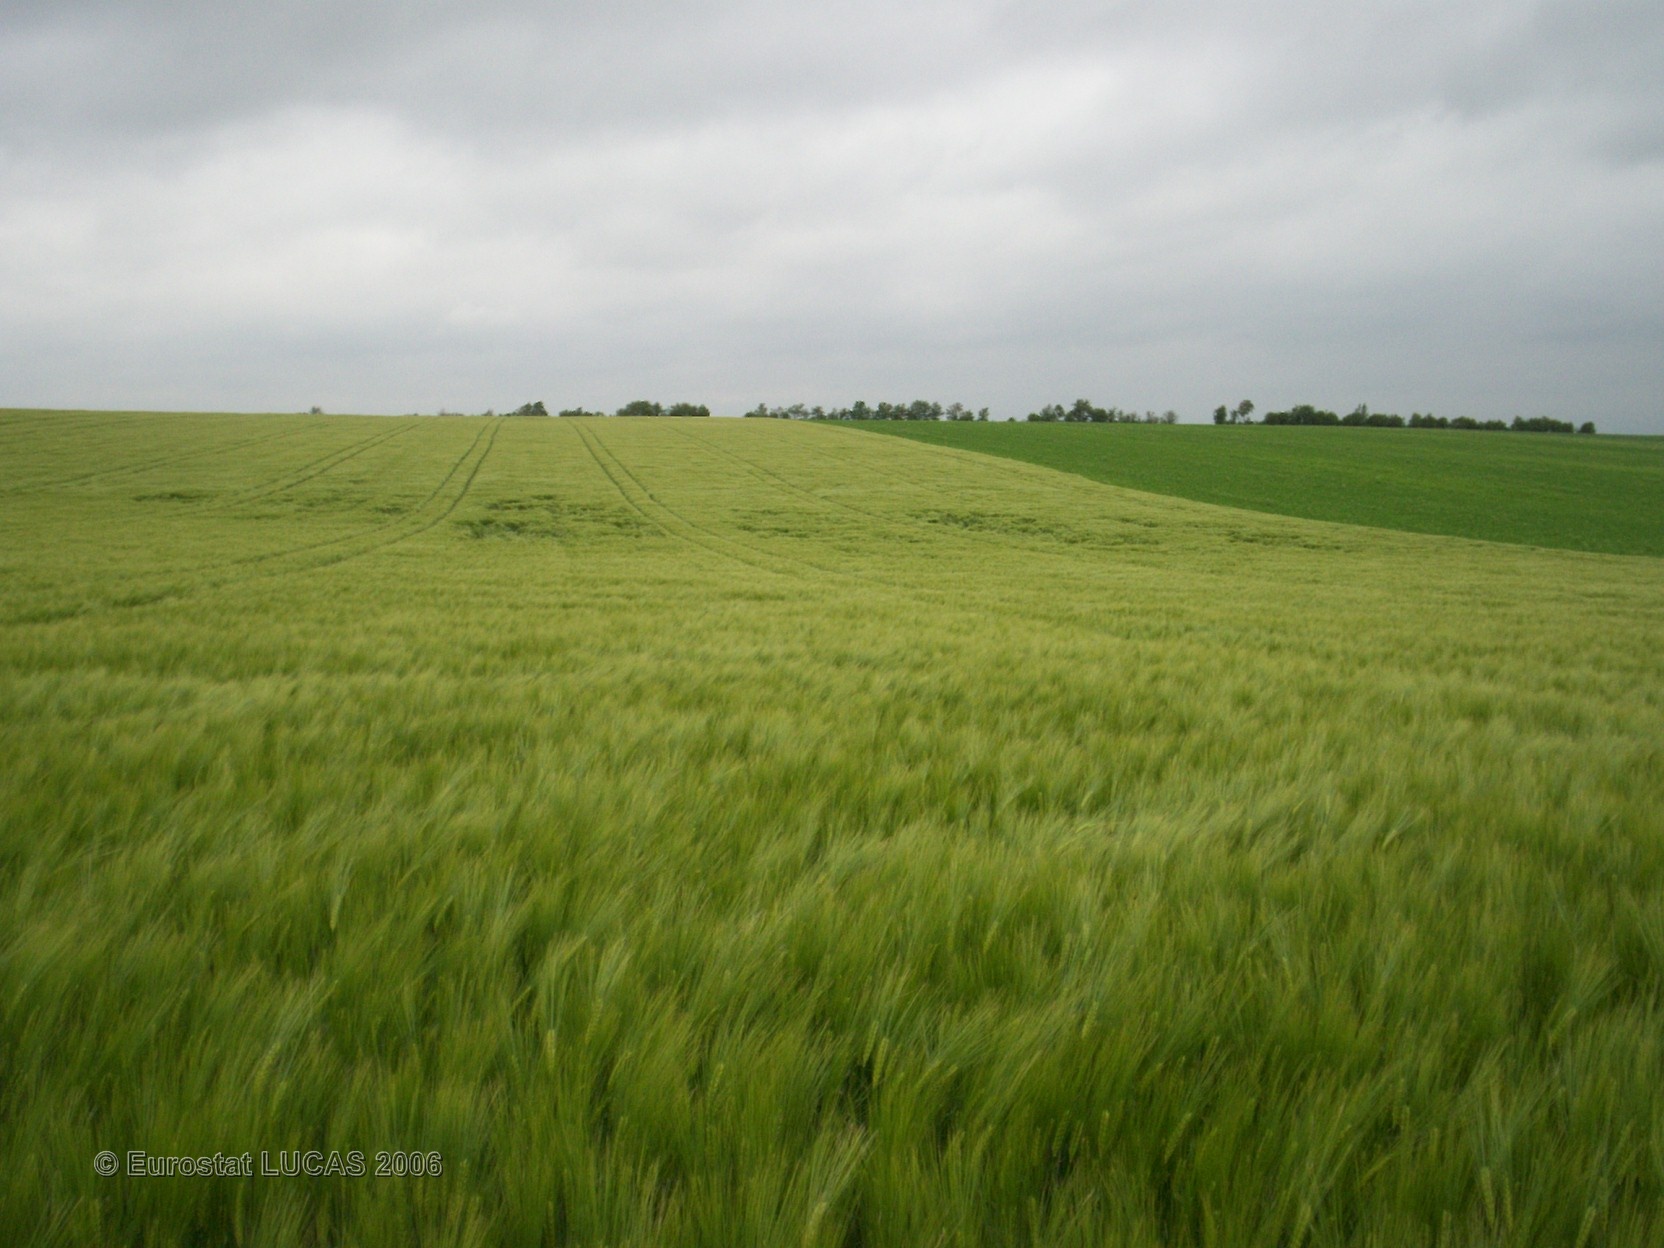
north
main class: Cropland
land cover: Barley
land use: Agriculture (excluding fallow land and kitchen gardens)
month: May
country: FR
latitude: 49.3447
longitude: 4.4216
